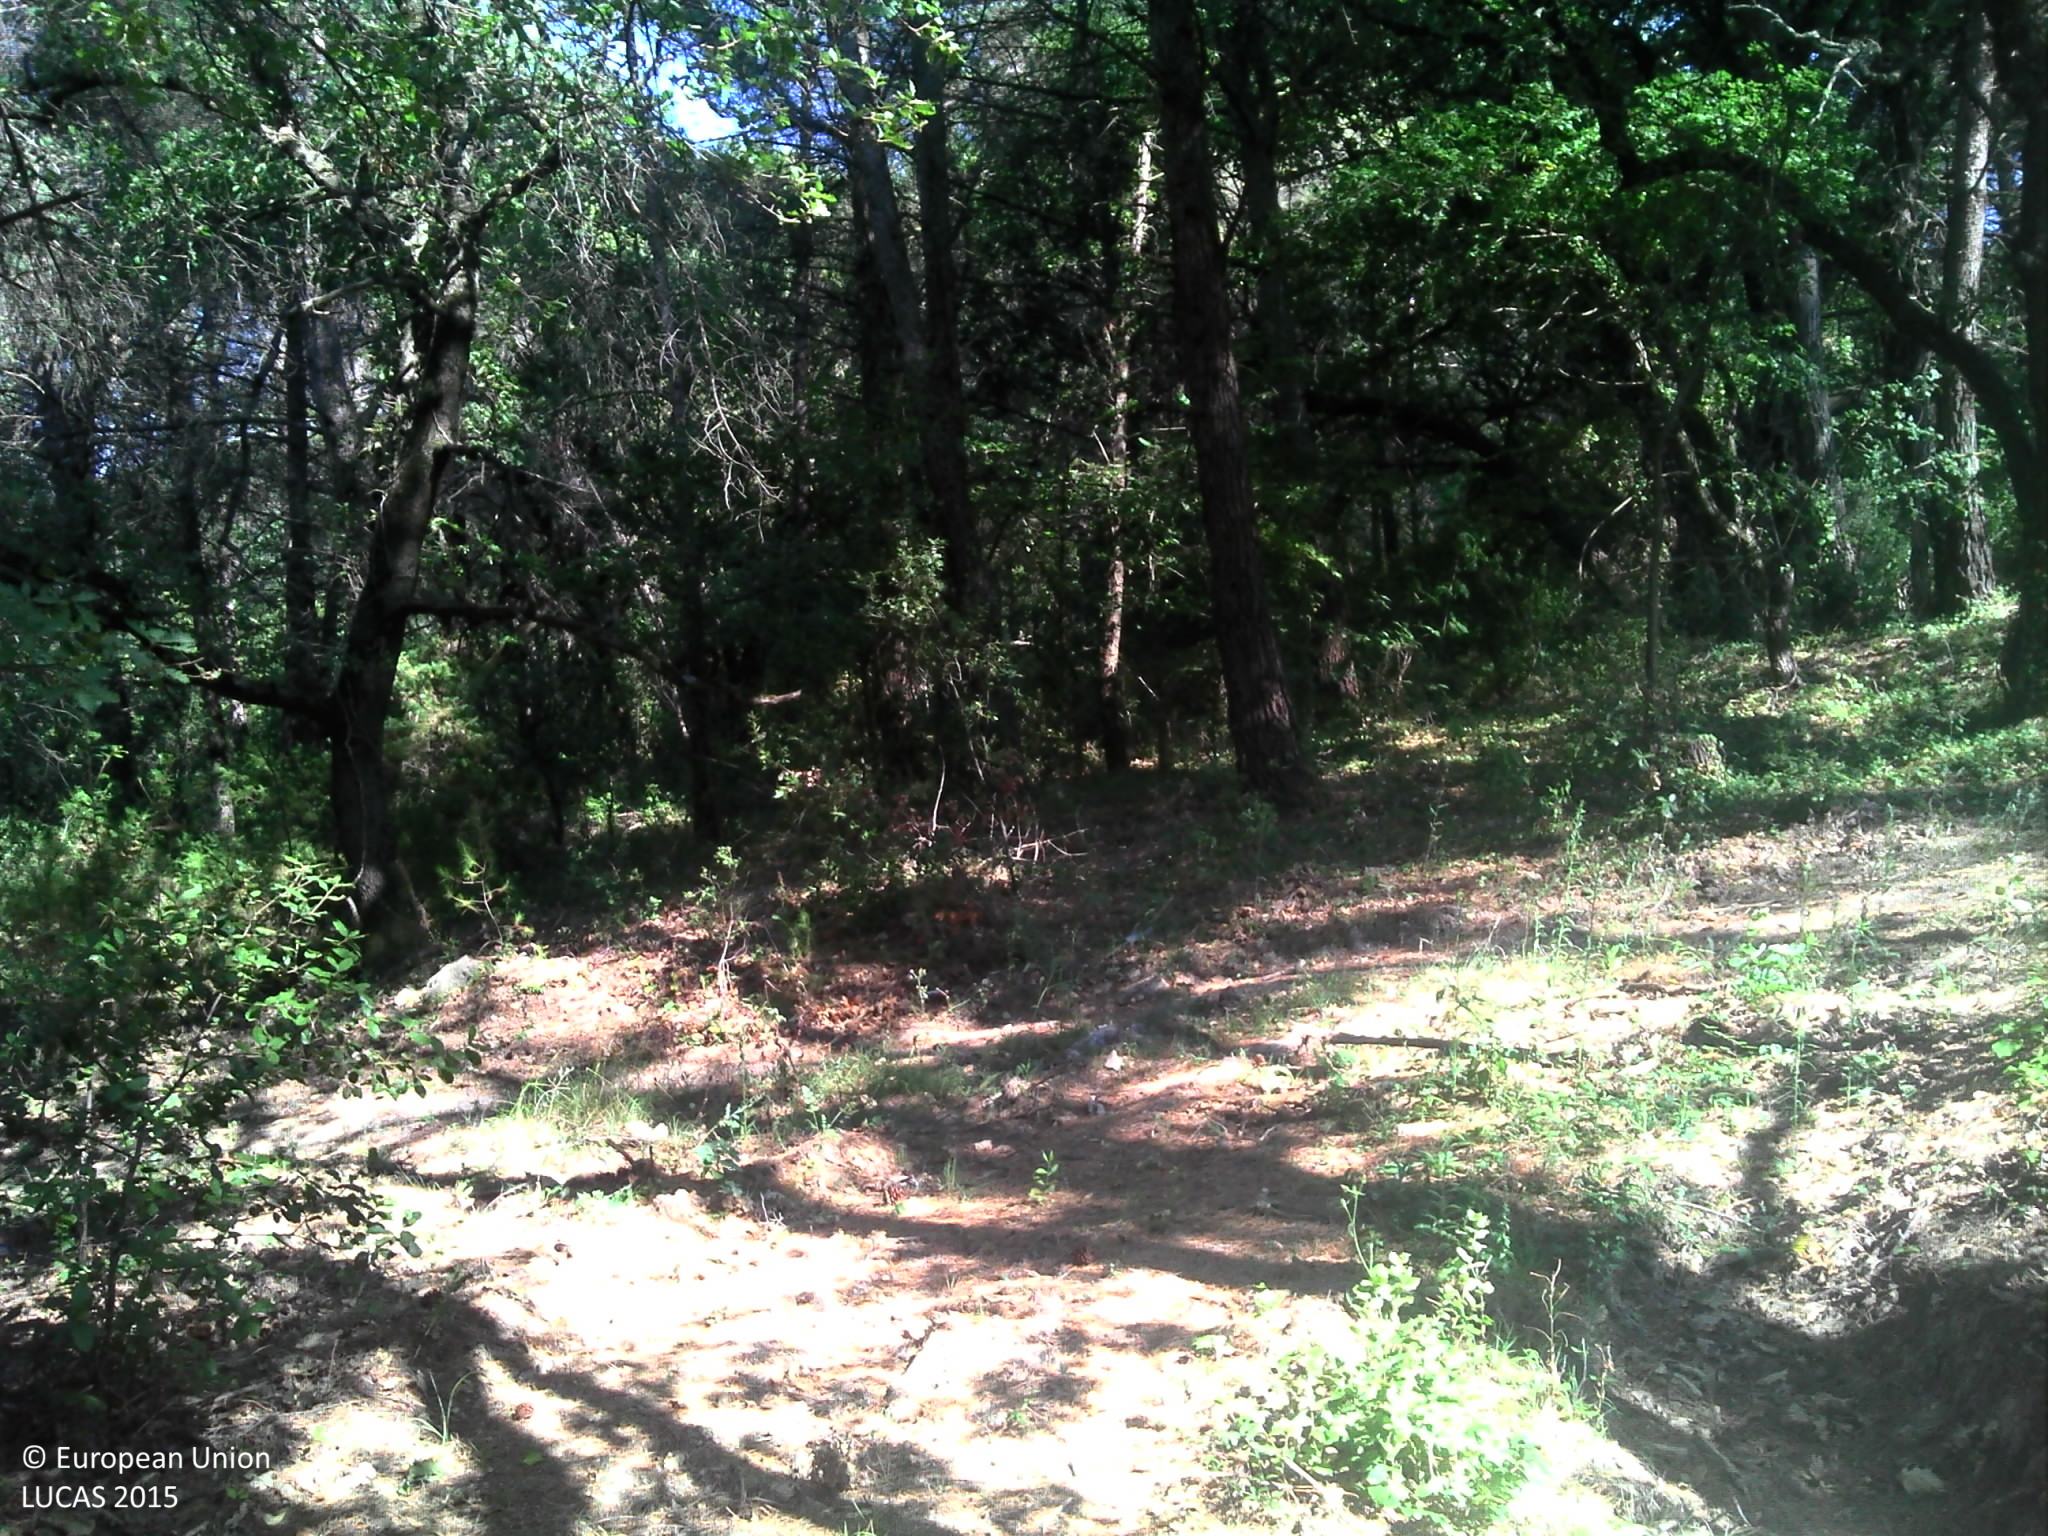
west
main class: Woodland
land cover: Pine dominated mixed woodland
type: coniferous forest of the mediterranean region
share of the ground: > 75 %
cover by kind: coniferous forest trees 50 %, broadleaved forest trees 50 %
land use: Forestry
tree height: > 5 m
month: August
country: FR
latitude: 43.3880
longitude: 5.5535
